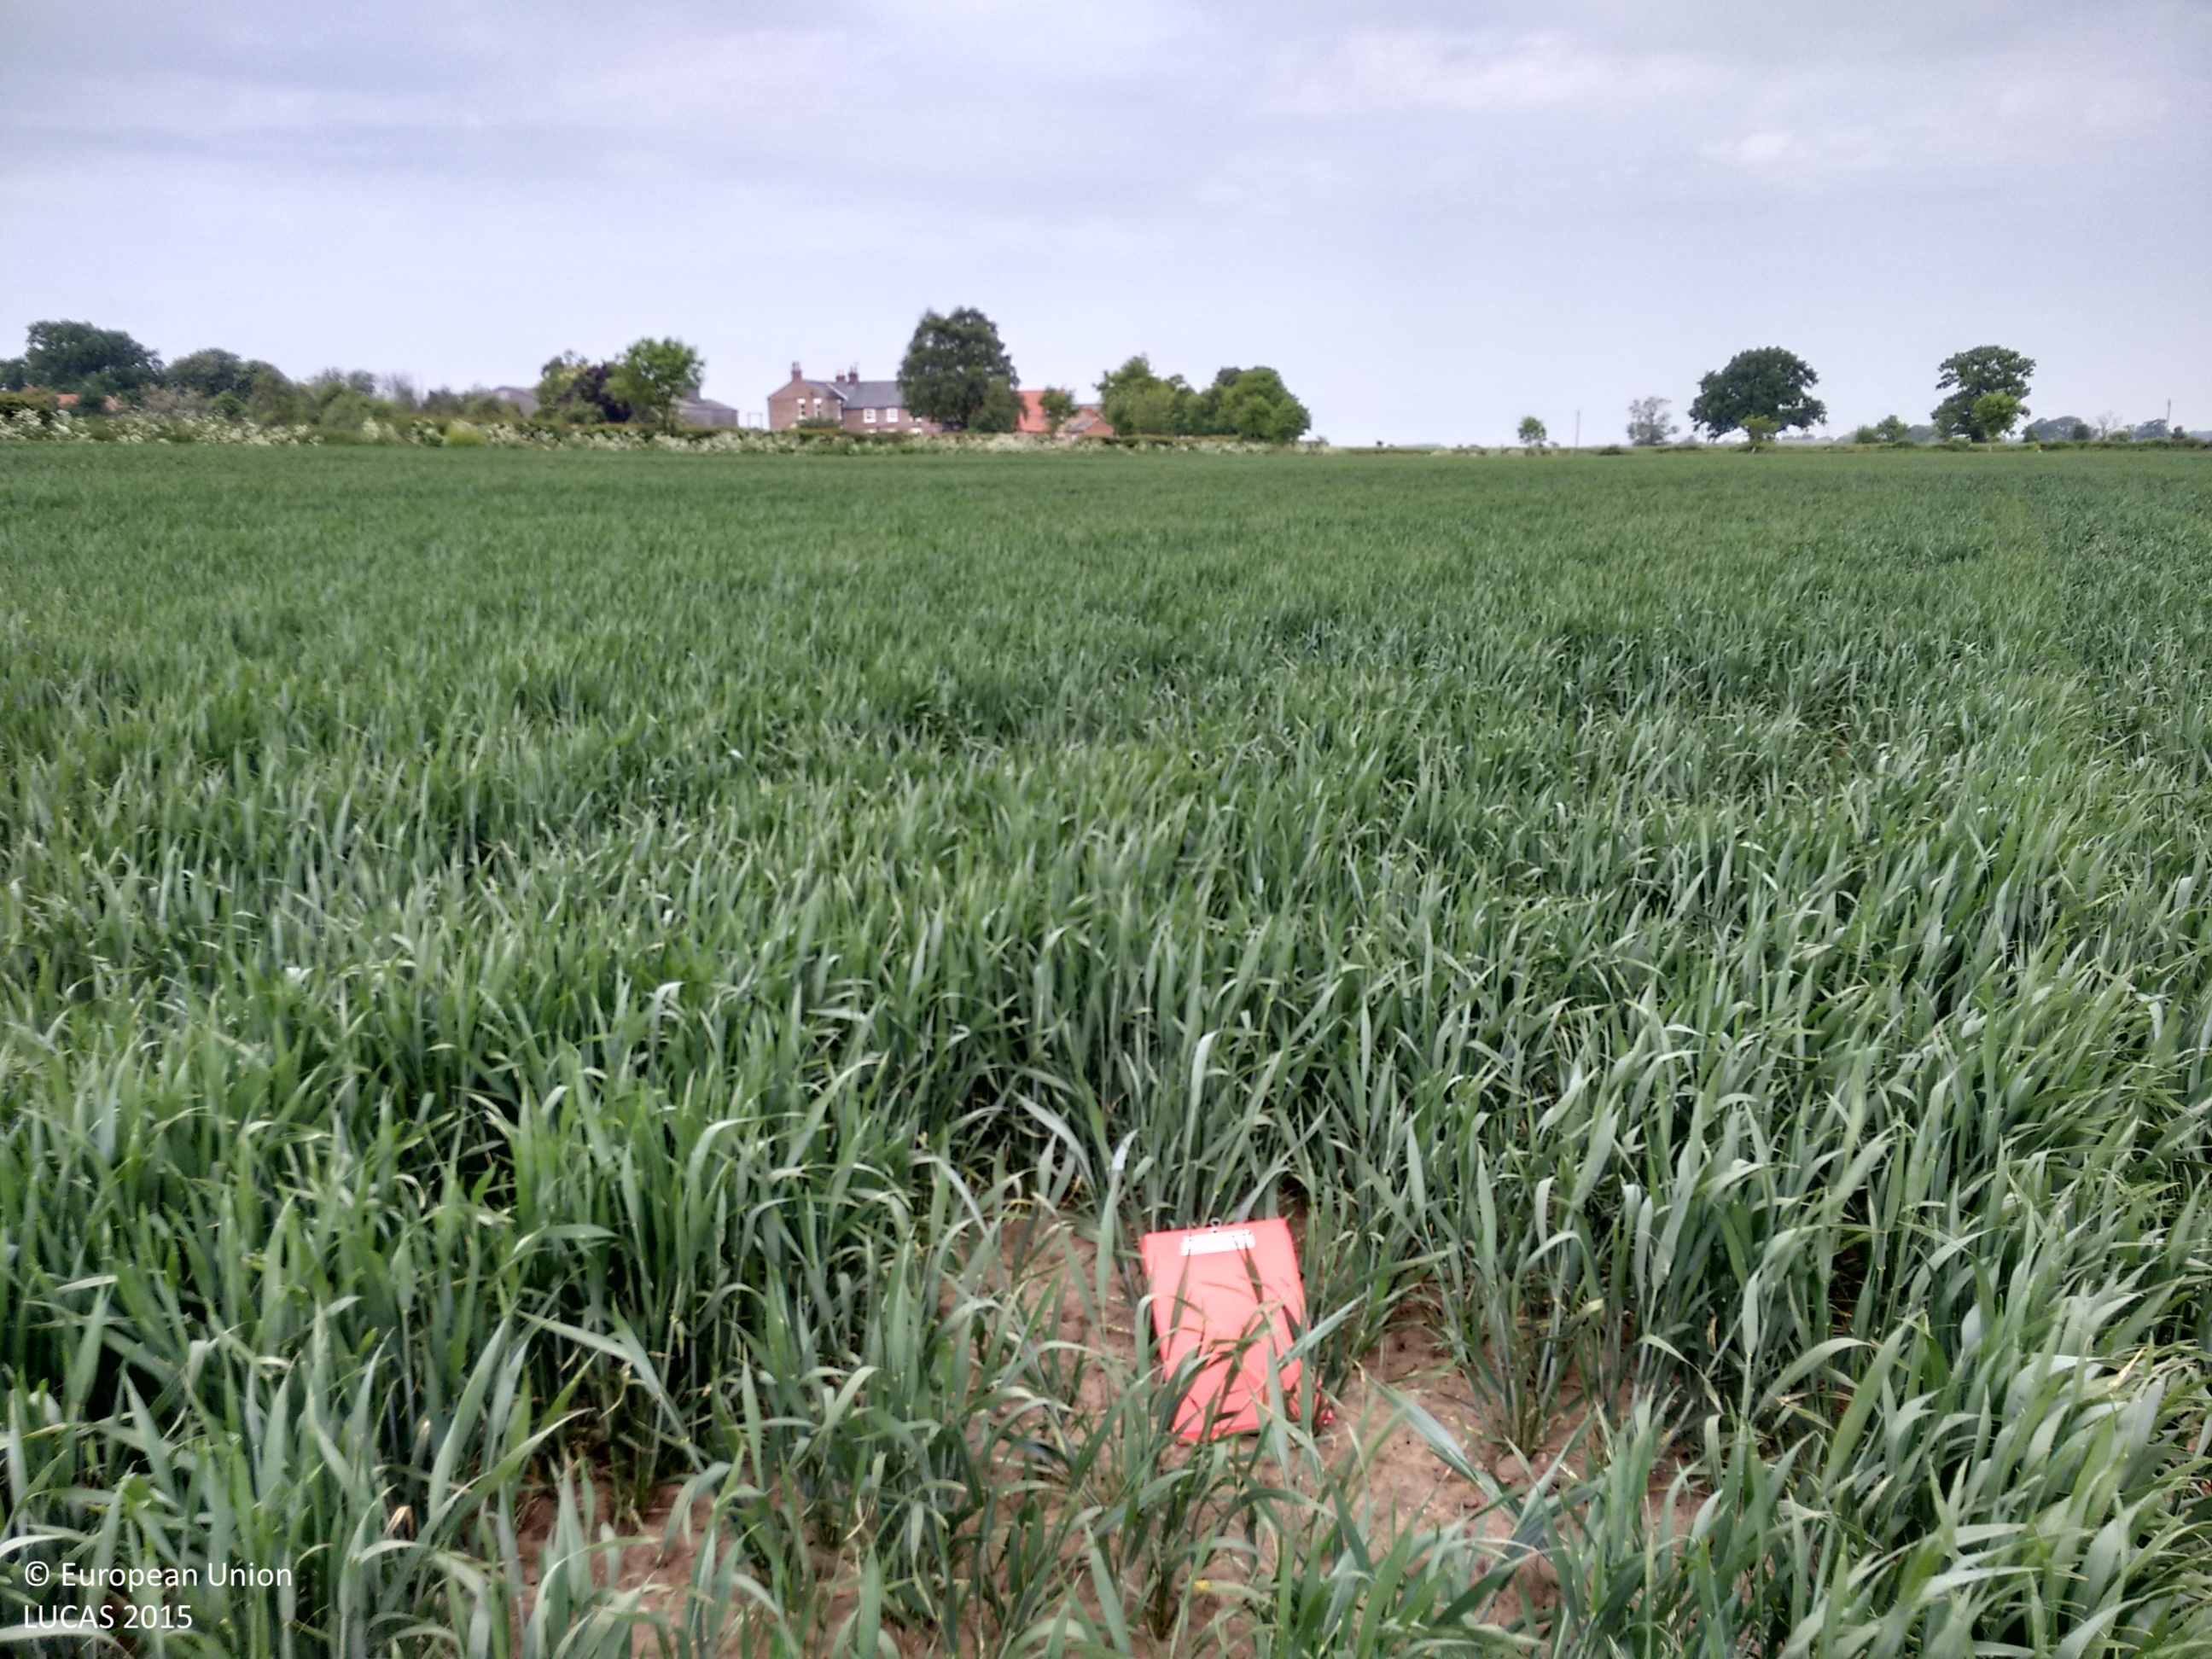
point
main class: Cropland
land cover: Common wheat
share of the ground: > 75 %
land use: Agriculture (excluding fallow land and kitchen gardens)
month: November
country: GB
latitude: 53.9915
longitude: -1.1639
